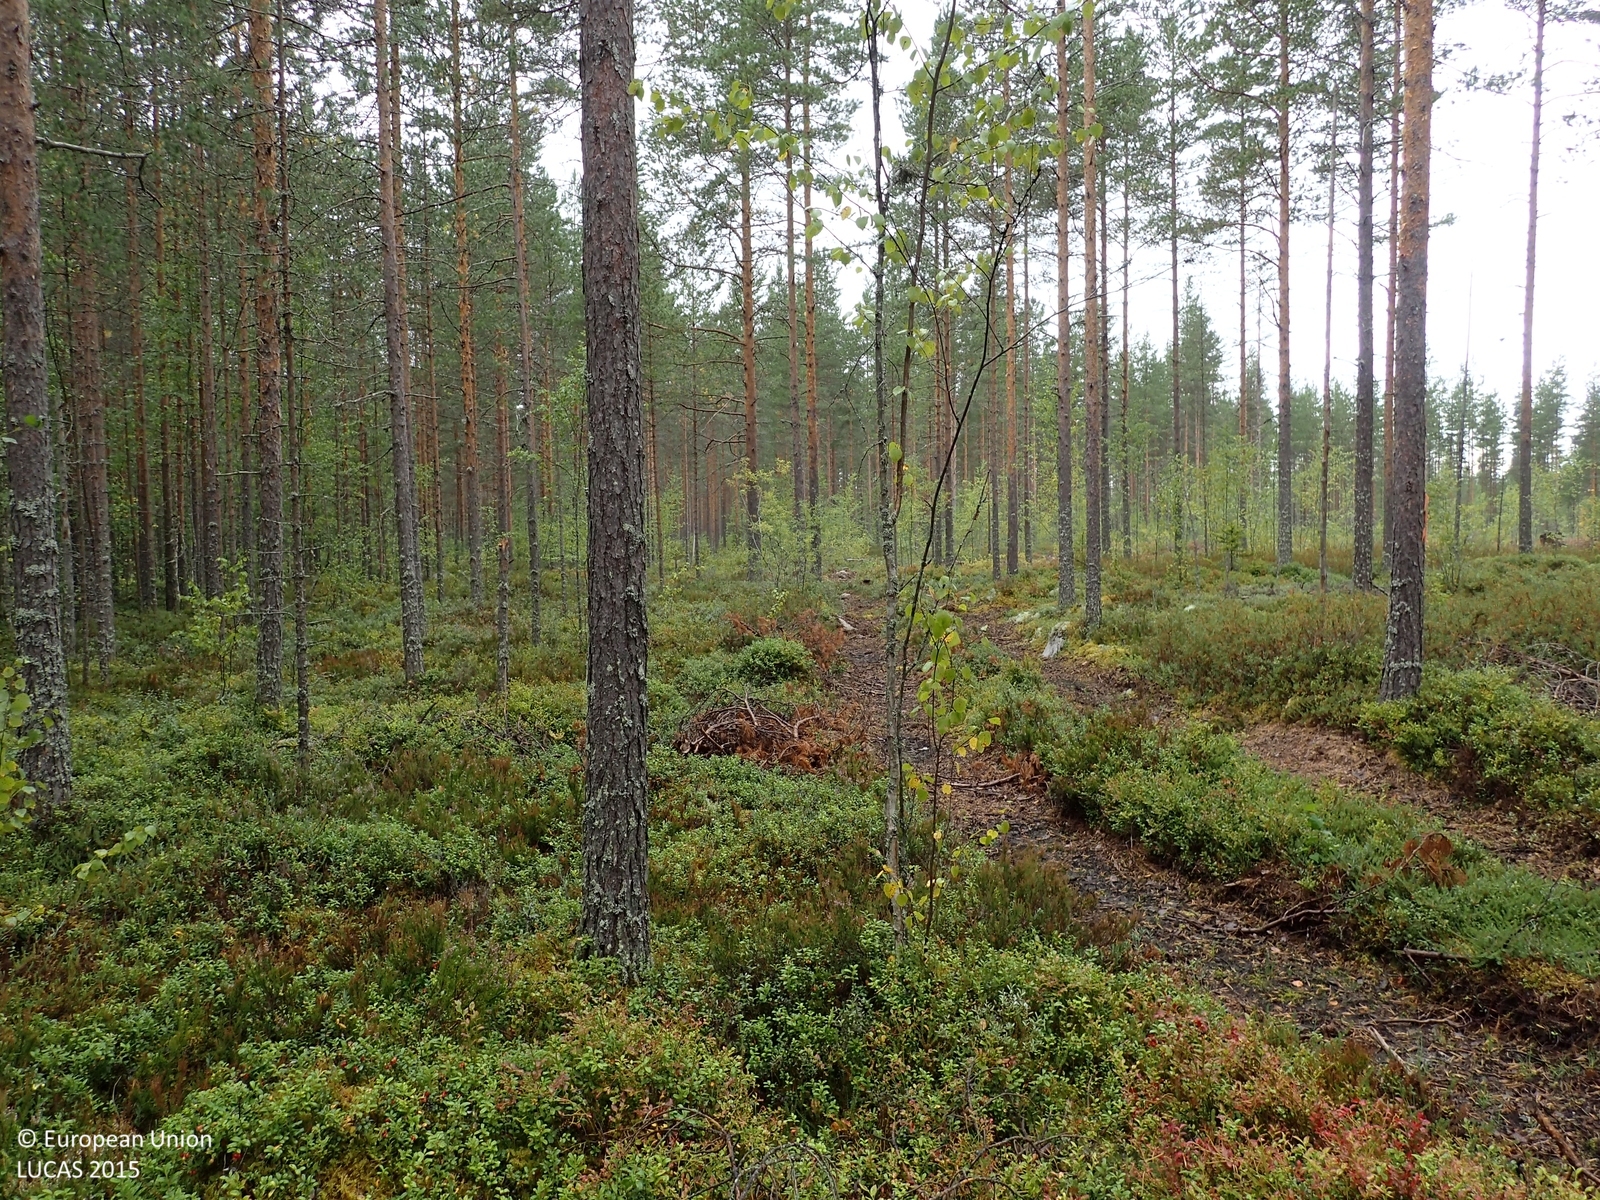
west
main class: Woodland
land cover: Pine dominated coniferous woodland
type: boreal forest
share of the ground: 50 - 75 %
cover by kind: coniferous forest trees 60 %, shrubs 25 %, lichens and mosses 10 %, broadleaved forest trees 5 %
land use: Forestry
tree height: > 5 m
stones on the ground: < 10 %
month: August
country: FI
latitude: 62.6692
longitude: 23.2039
